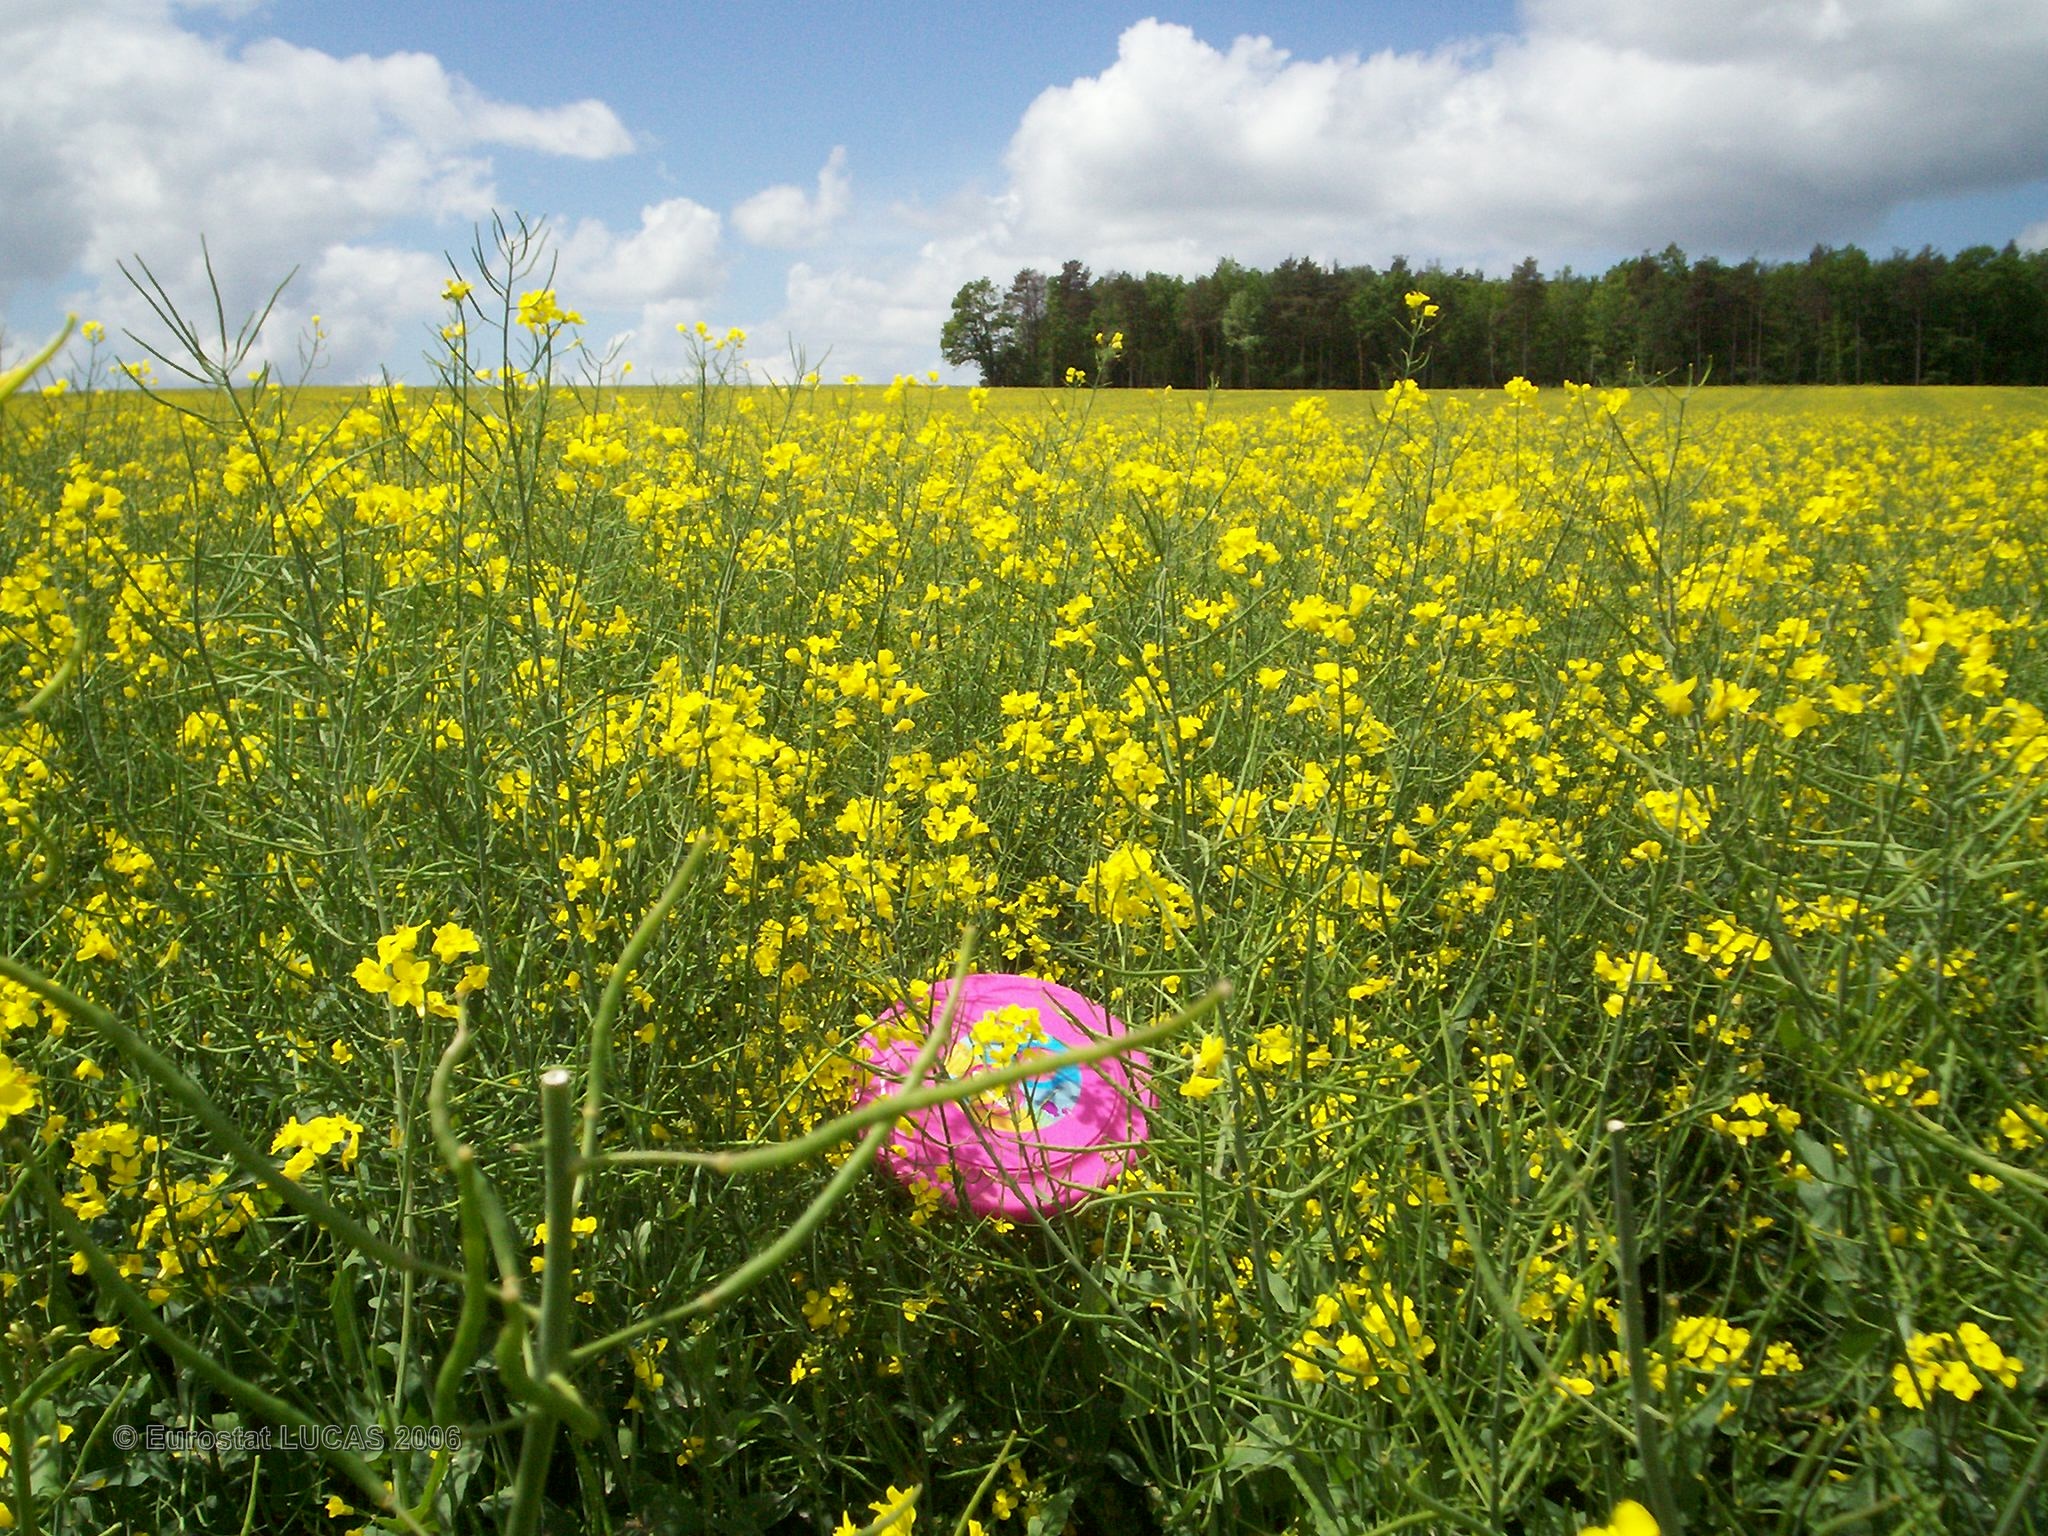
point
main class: Cropland
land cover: Rape and turnip rape
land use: Agriculture (excluding fallow land and kitchen gardens)
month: May
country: FR
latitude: 47.7208
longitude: 4.0652
